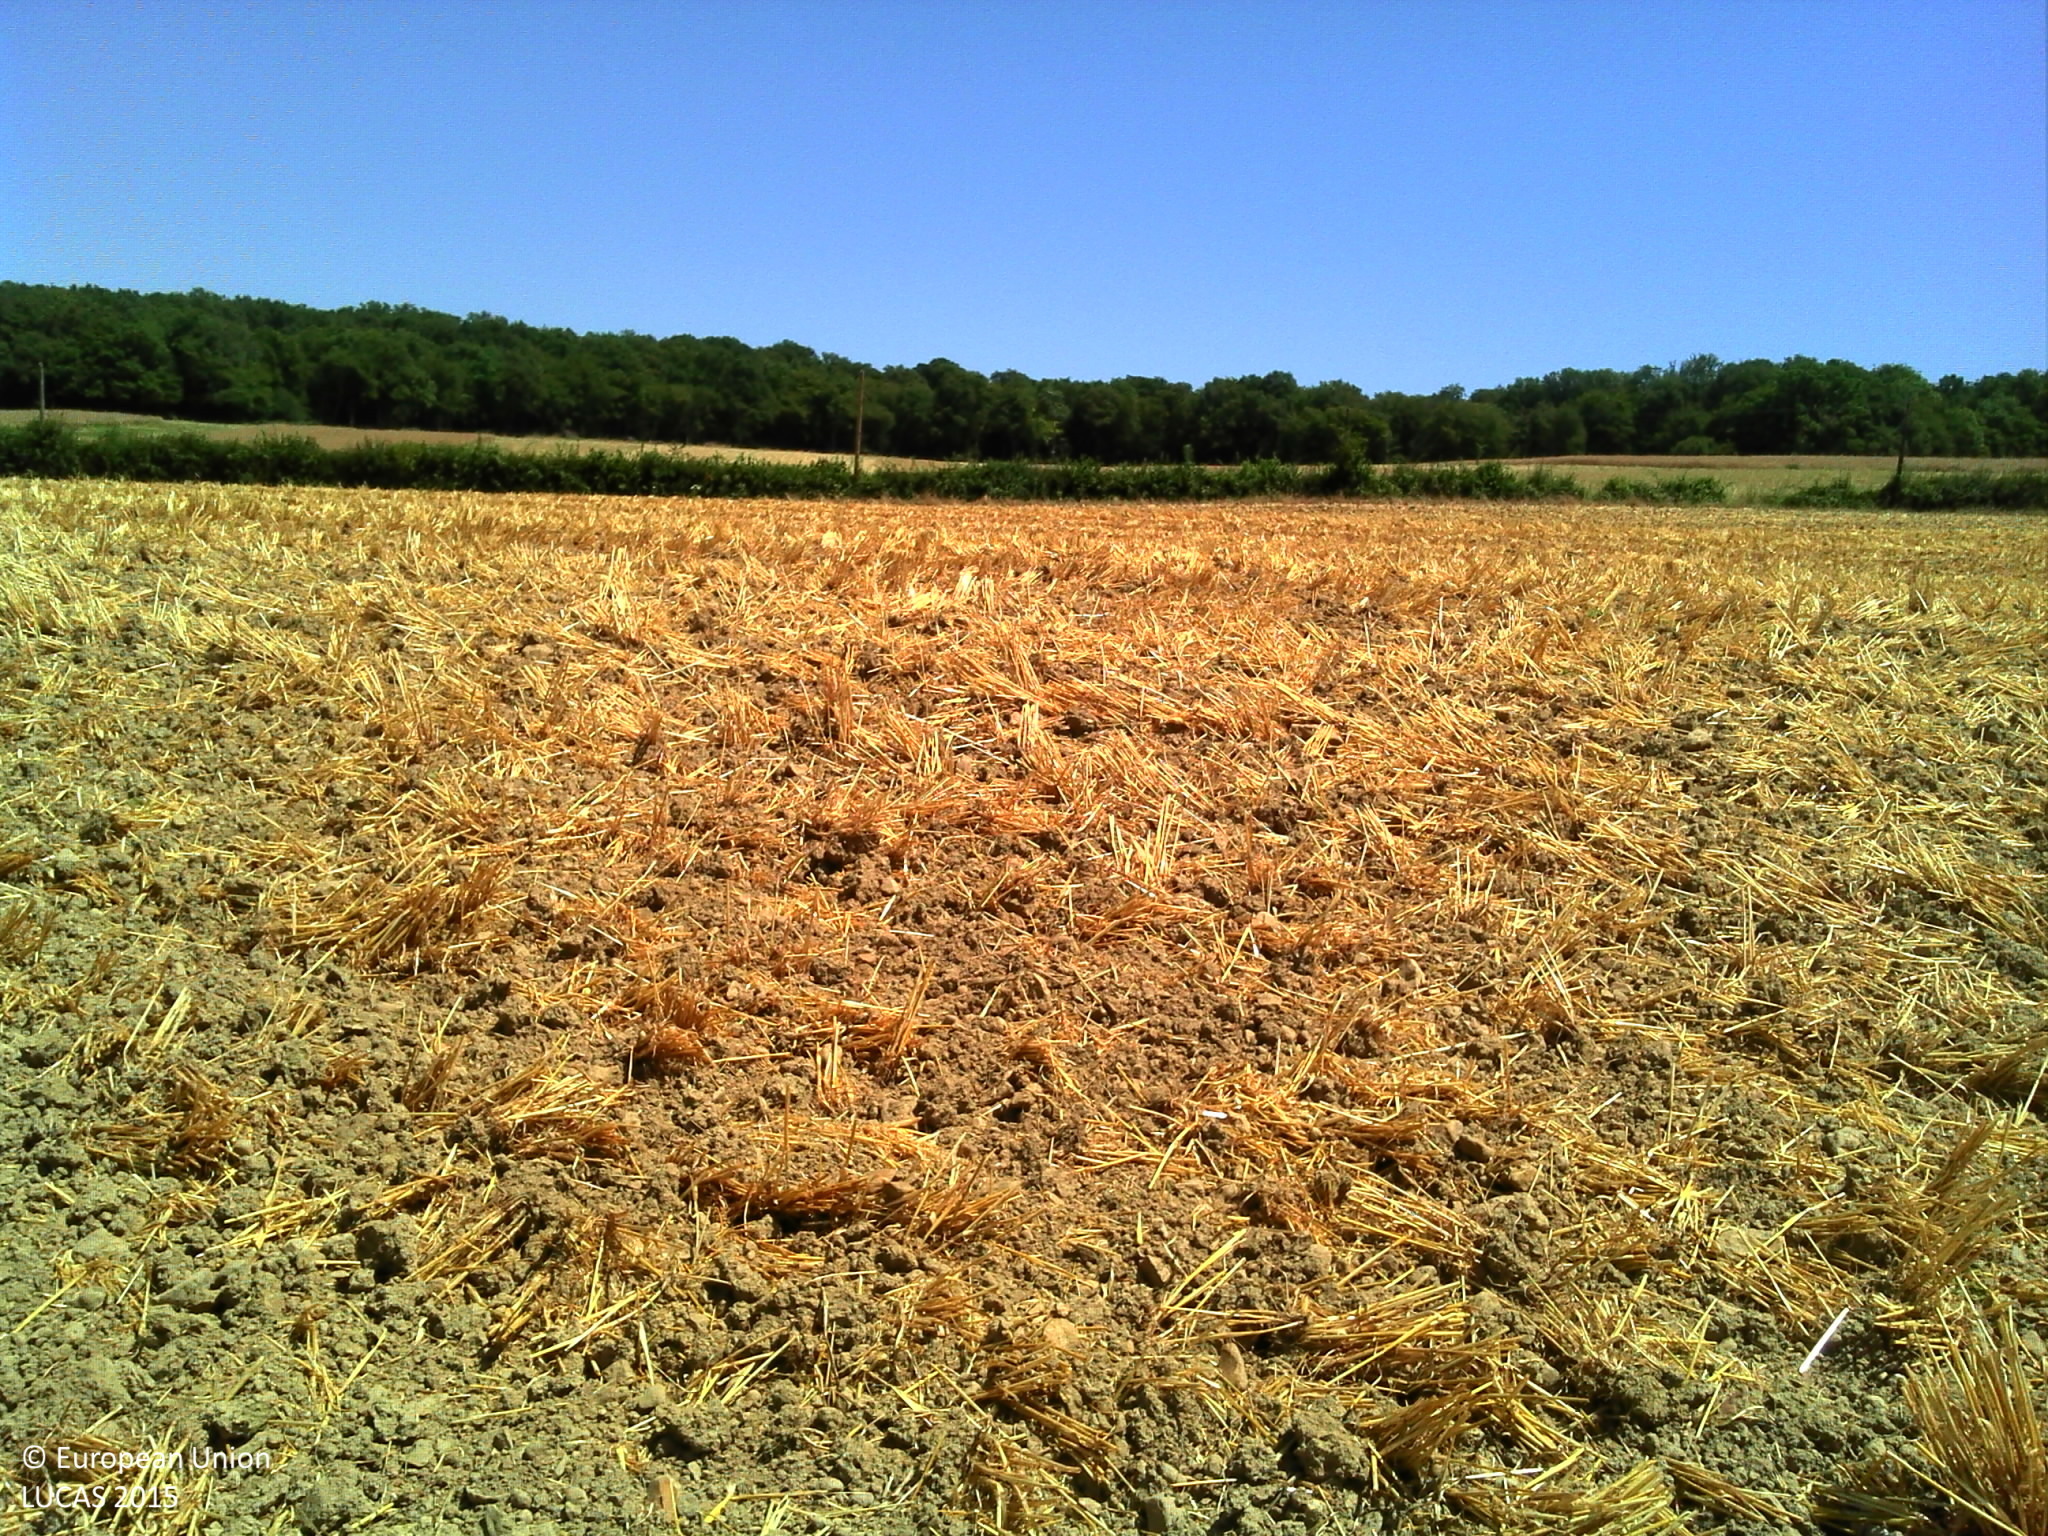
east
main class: Cropland
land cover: Barley
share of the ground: > 75 %
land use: Agriculture (excluding fallow land and kitchen gardens)
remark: Harvested field
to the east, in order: Barley; Grass margins; Paved roads, cycling and walking lanes; Grass margins; Ditches and canals; Electric lines; Managed hedges; Rape and turnip rape
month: July
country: FR
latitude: 46.9152
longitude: 3.5508
